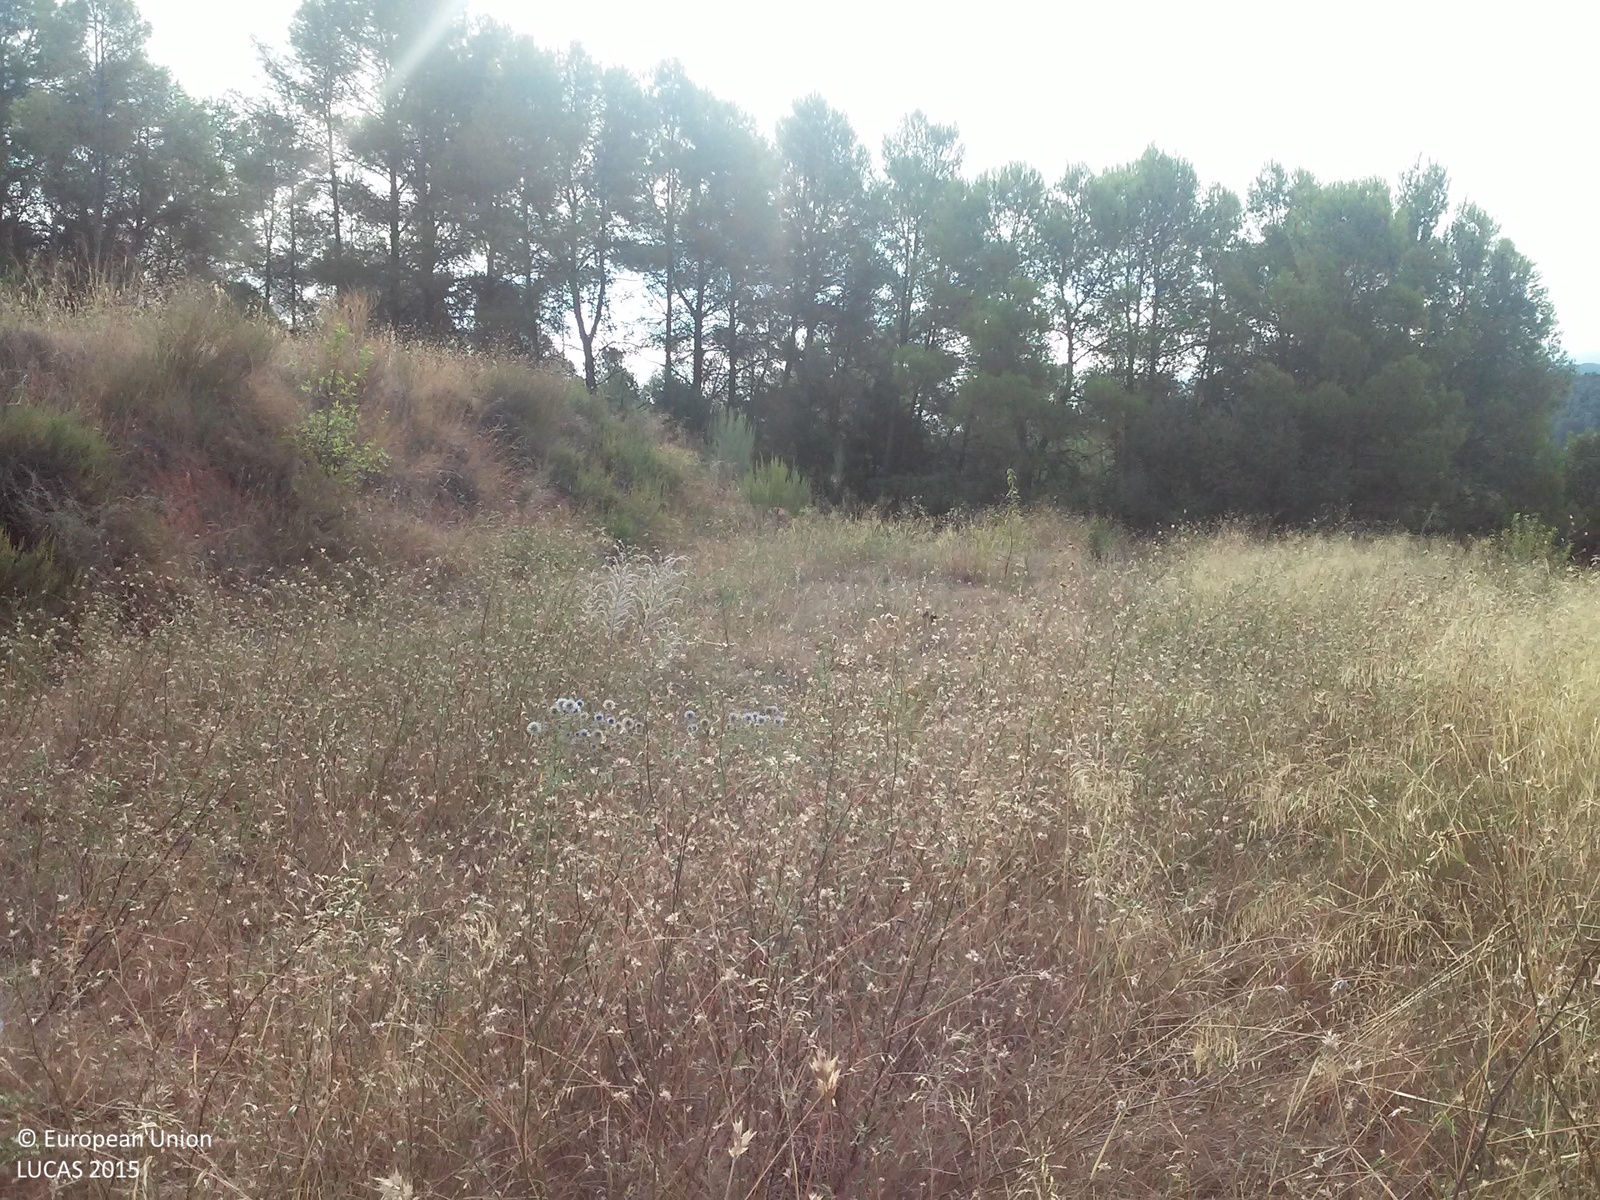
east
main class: Grassland
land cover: Spontaneously vegetated surfaces
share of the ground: > 75 %
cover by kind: herbaceous plants 95 %, consolidated bare surface 5 %
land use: Fallow land
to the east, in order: Spontaneously vegetated surfaces; Tracks; Pine dominated coniferous woodland; Tracks; Pine dominated coniferous woodland
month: August
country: ES
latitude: 41.0596
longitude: 0.6753
